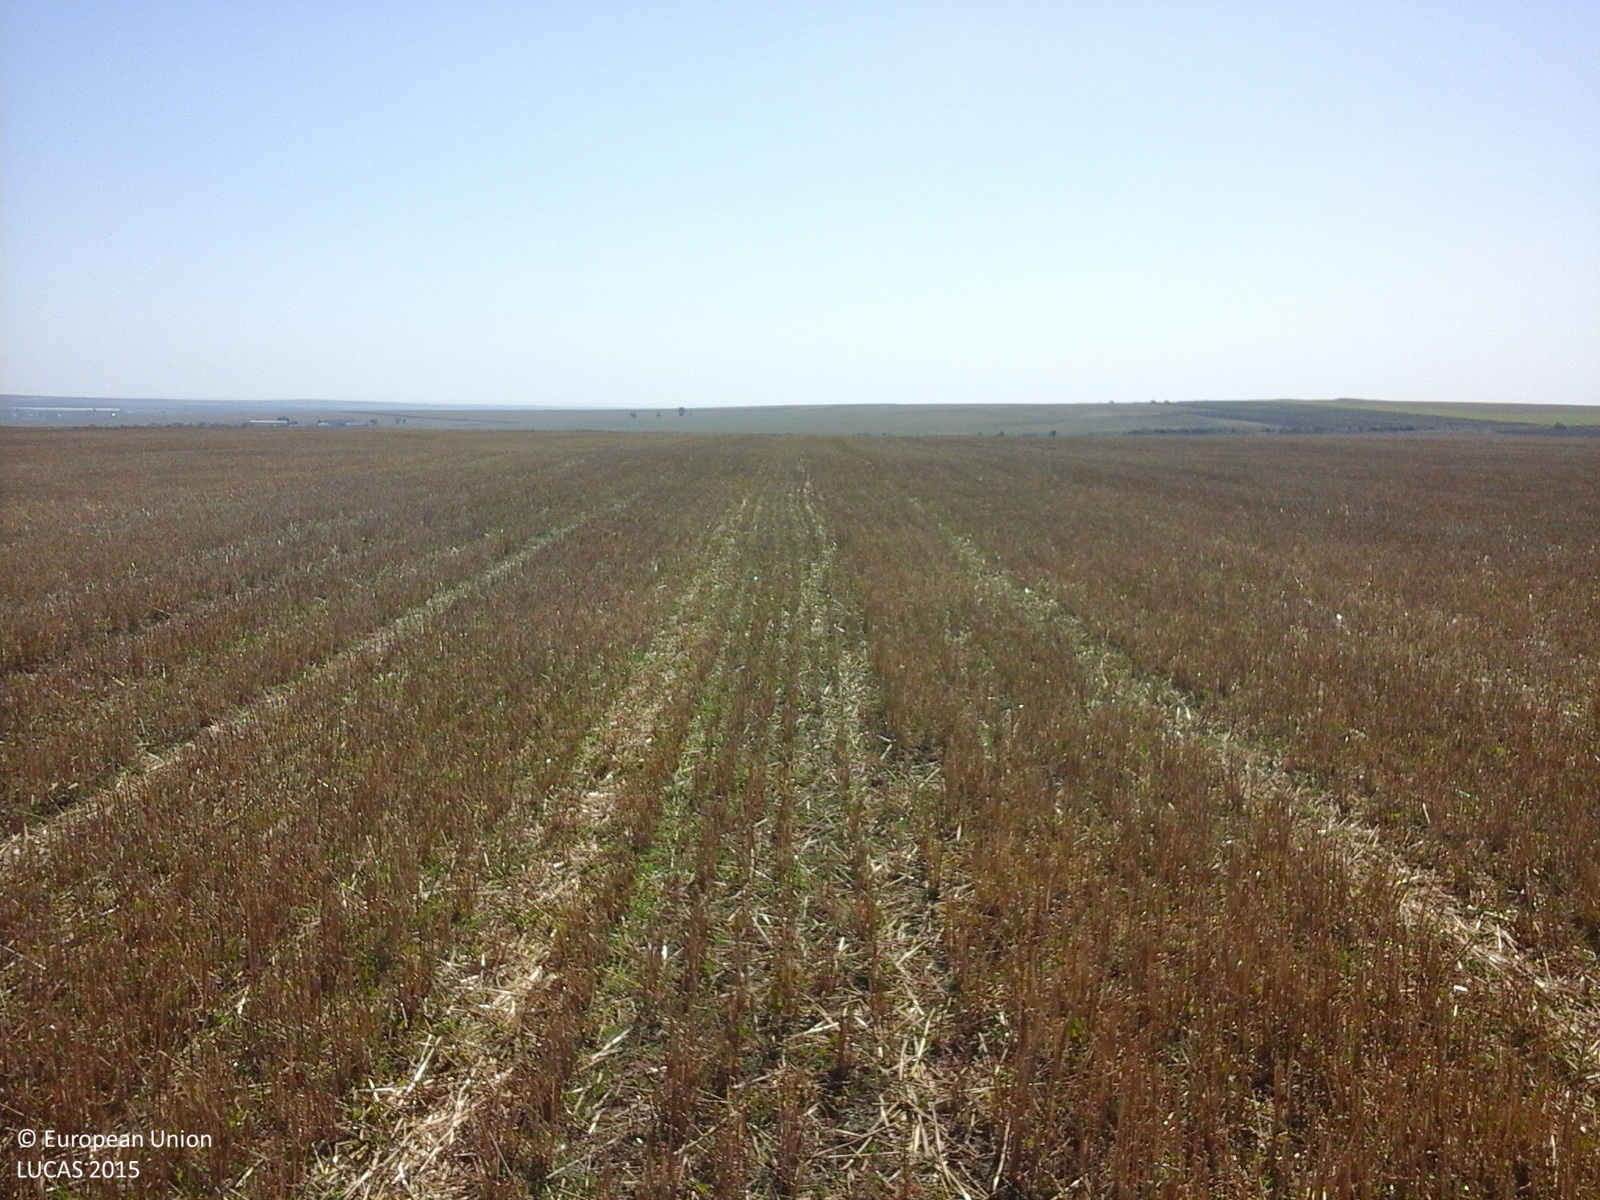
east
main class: Cropland
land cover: Common wheat
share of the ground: > 75 %
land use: Agriculture (excluding fallow land and kitchen gardens)
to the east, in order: Common wheat; Sunflower
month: August
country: RO
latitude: 44.5456
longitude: 28.5397
